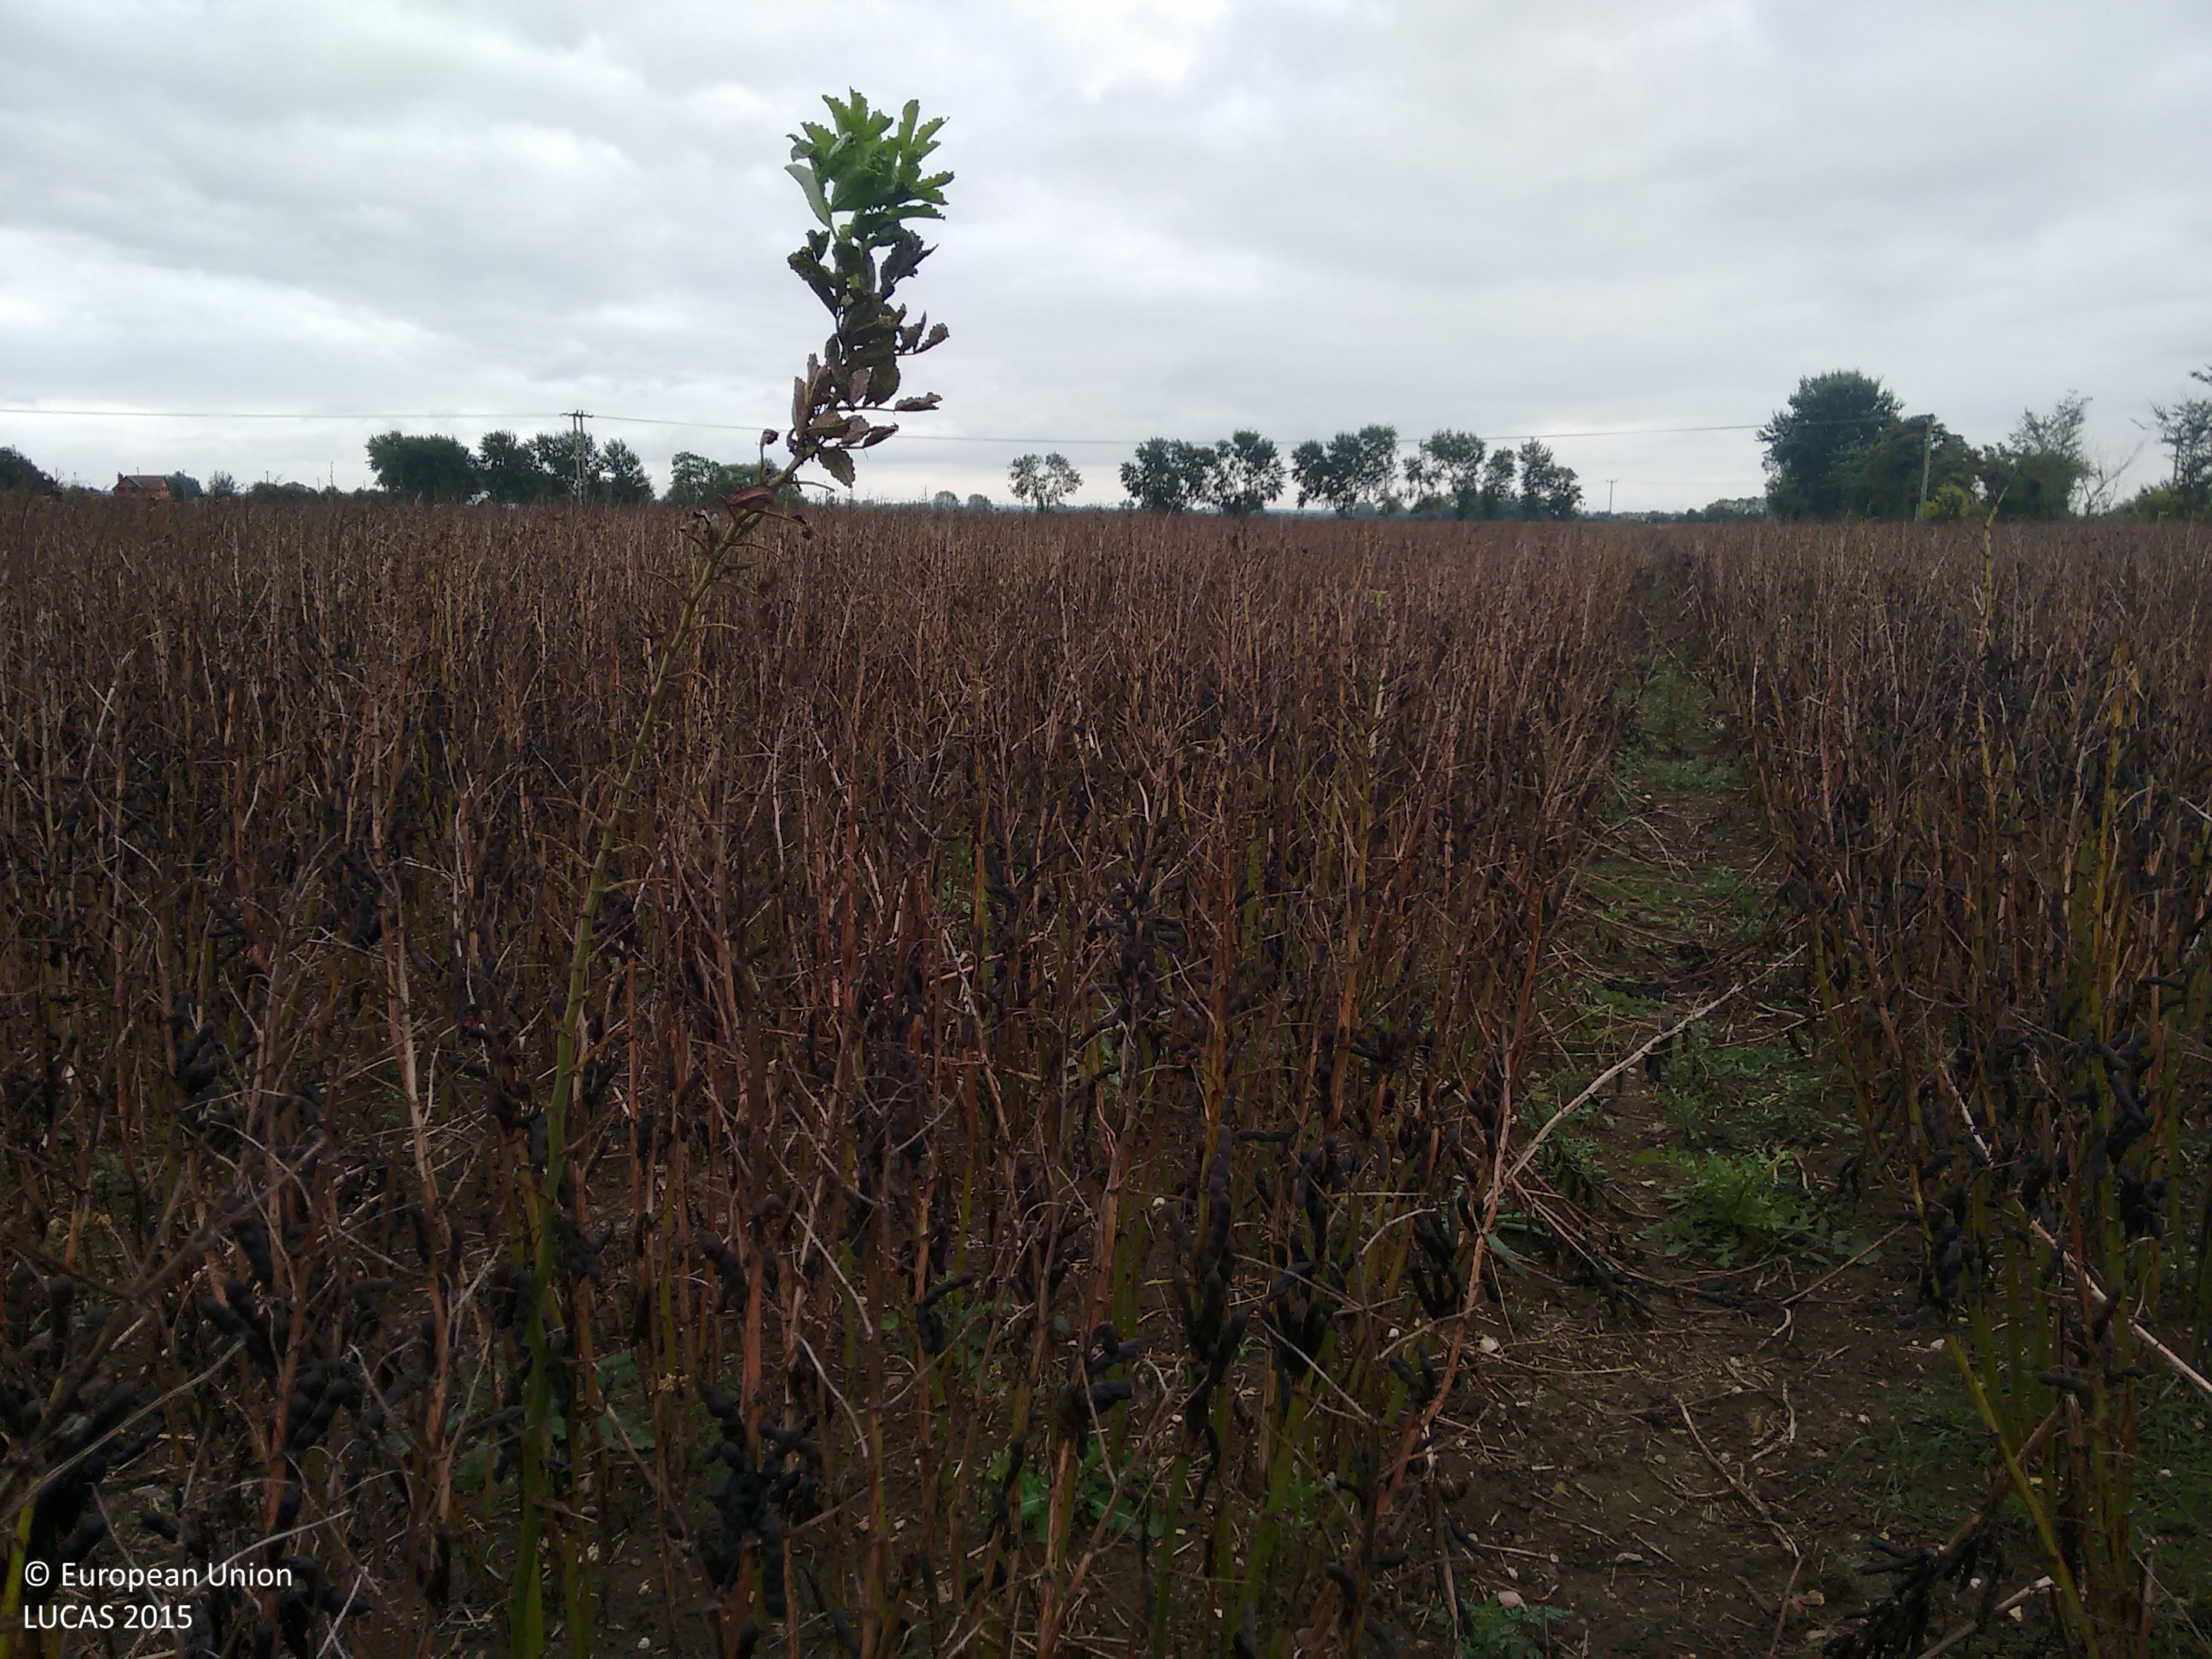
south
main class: Cropland
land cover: Dry pulses
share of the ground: > 75 %
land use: Agriculture (excluding fallow land and kitchen gardens)
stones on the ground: < 10 %
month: September
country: GB
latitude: 52.3260
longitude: 0.3307
